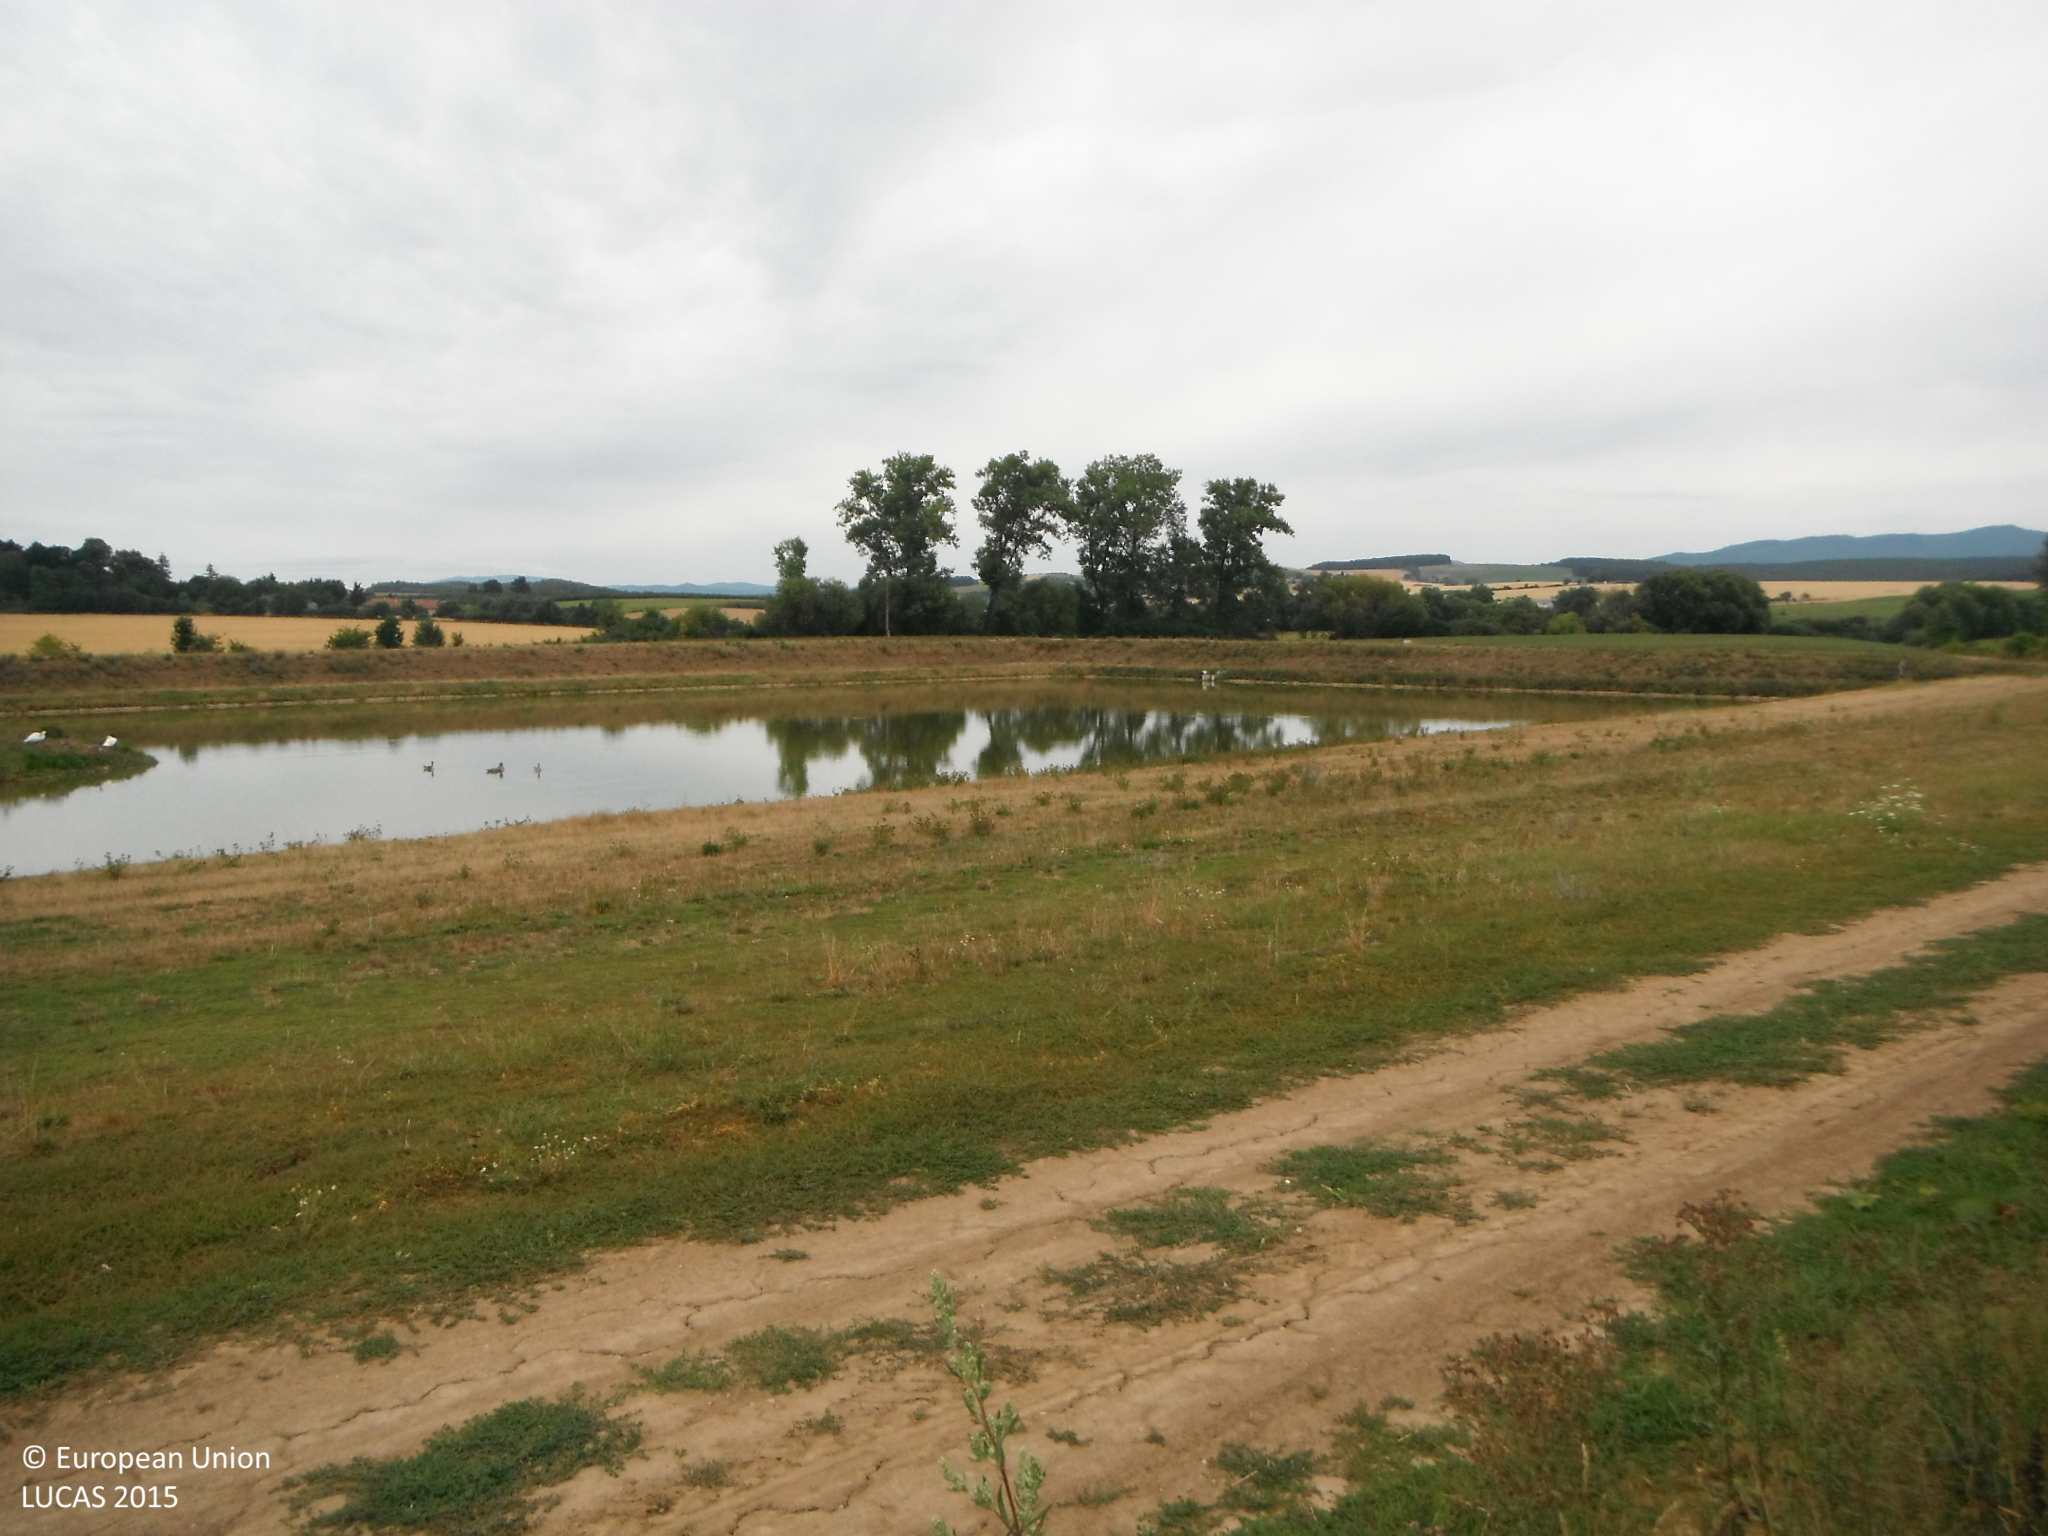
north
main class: Cropland
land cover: Permanent crops (only in case pi)
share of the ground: 50 - 75 %
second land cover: Grassland without tree/shrub cover
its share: > 75 %
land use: Agriculture (excluding fallow land and kitchen gardens)
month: July
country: SK
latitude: 48.6510
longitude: 18.3096
